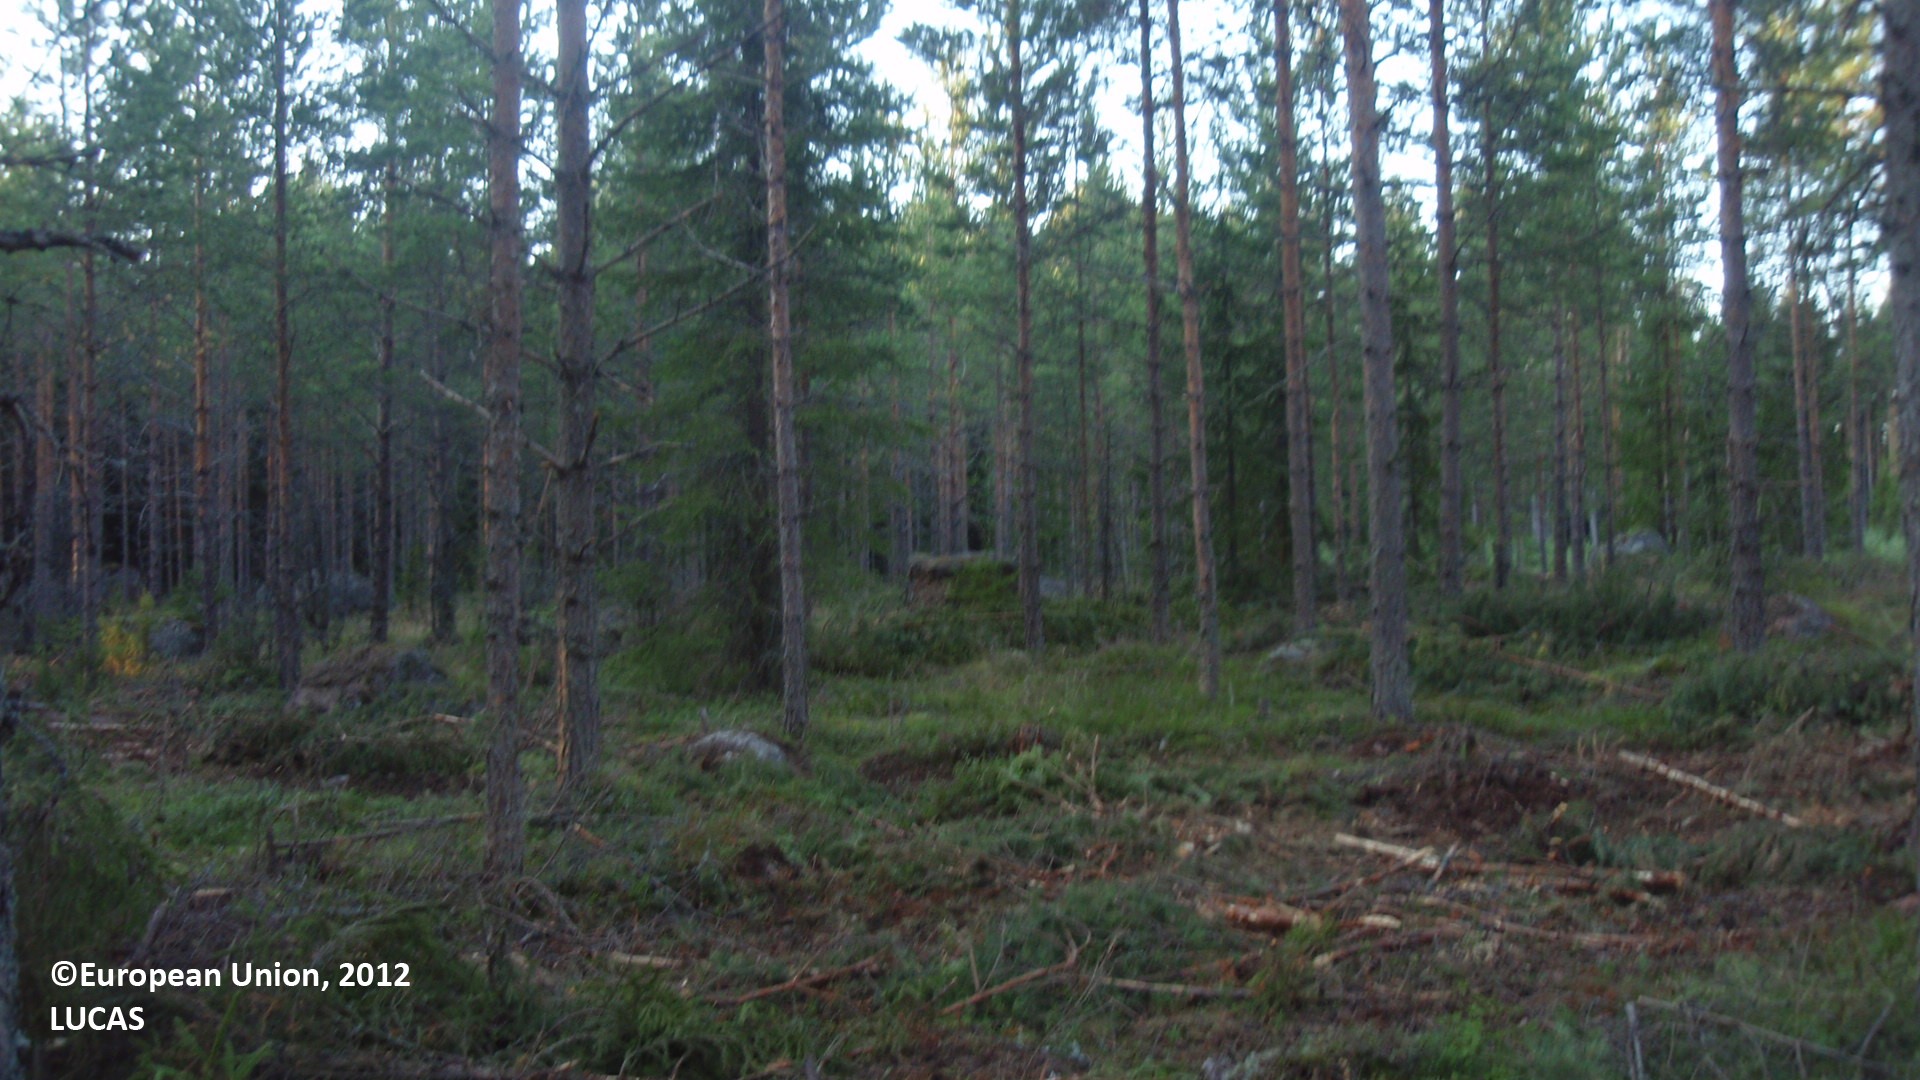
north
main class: Woodland
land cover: Pine dominated coniferous woodland
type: boreal forest
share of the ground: 50 - 75 %
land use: Forestry
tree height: > 5 m
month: August
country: FI
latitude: 60.5292
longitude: 27.4029
